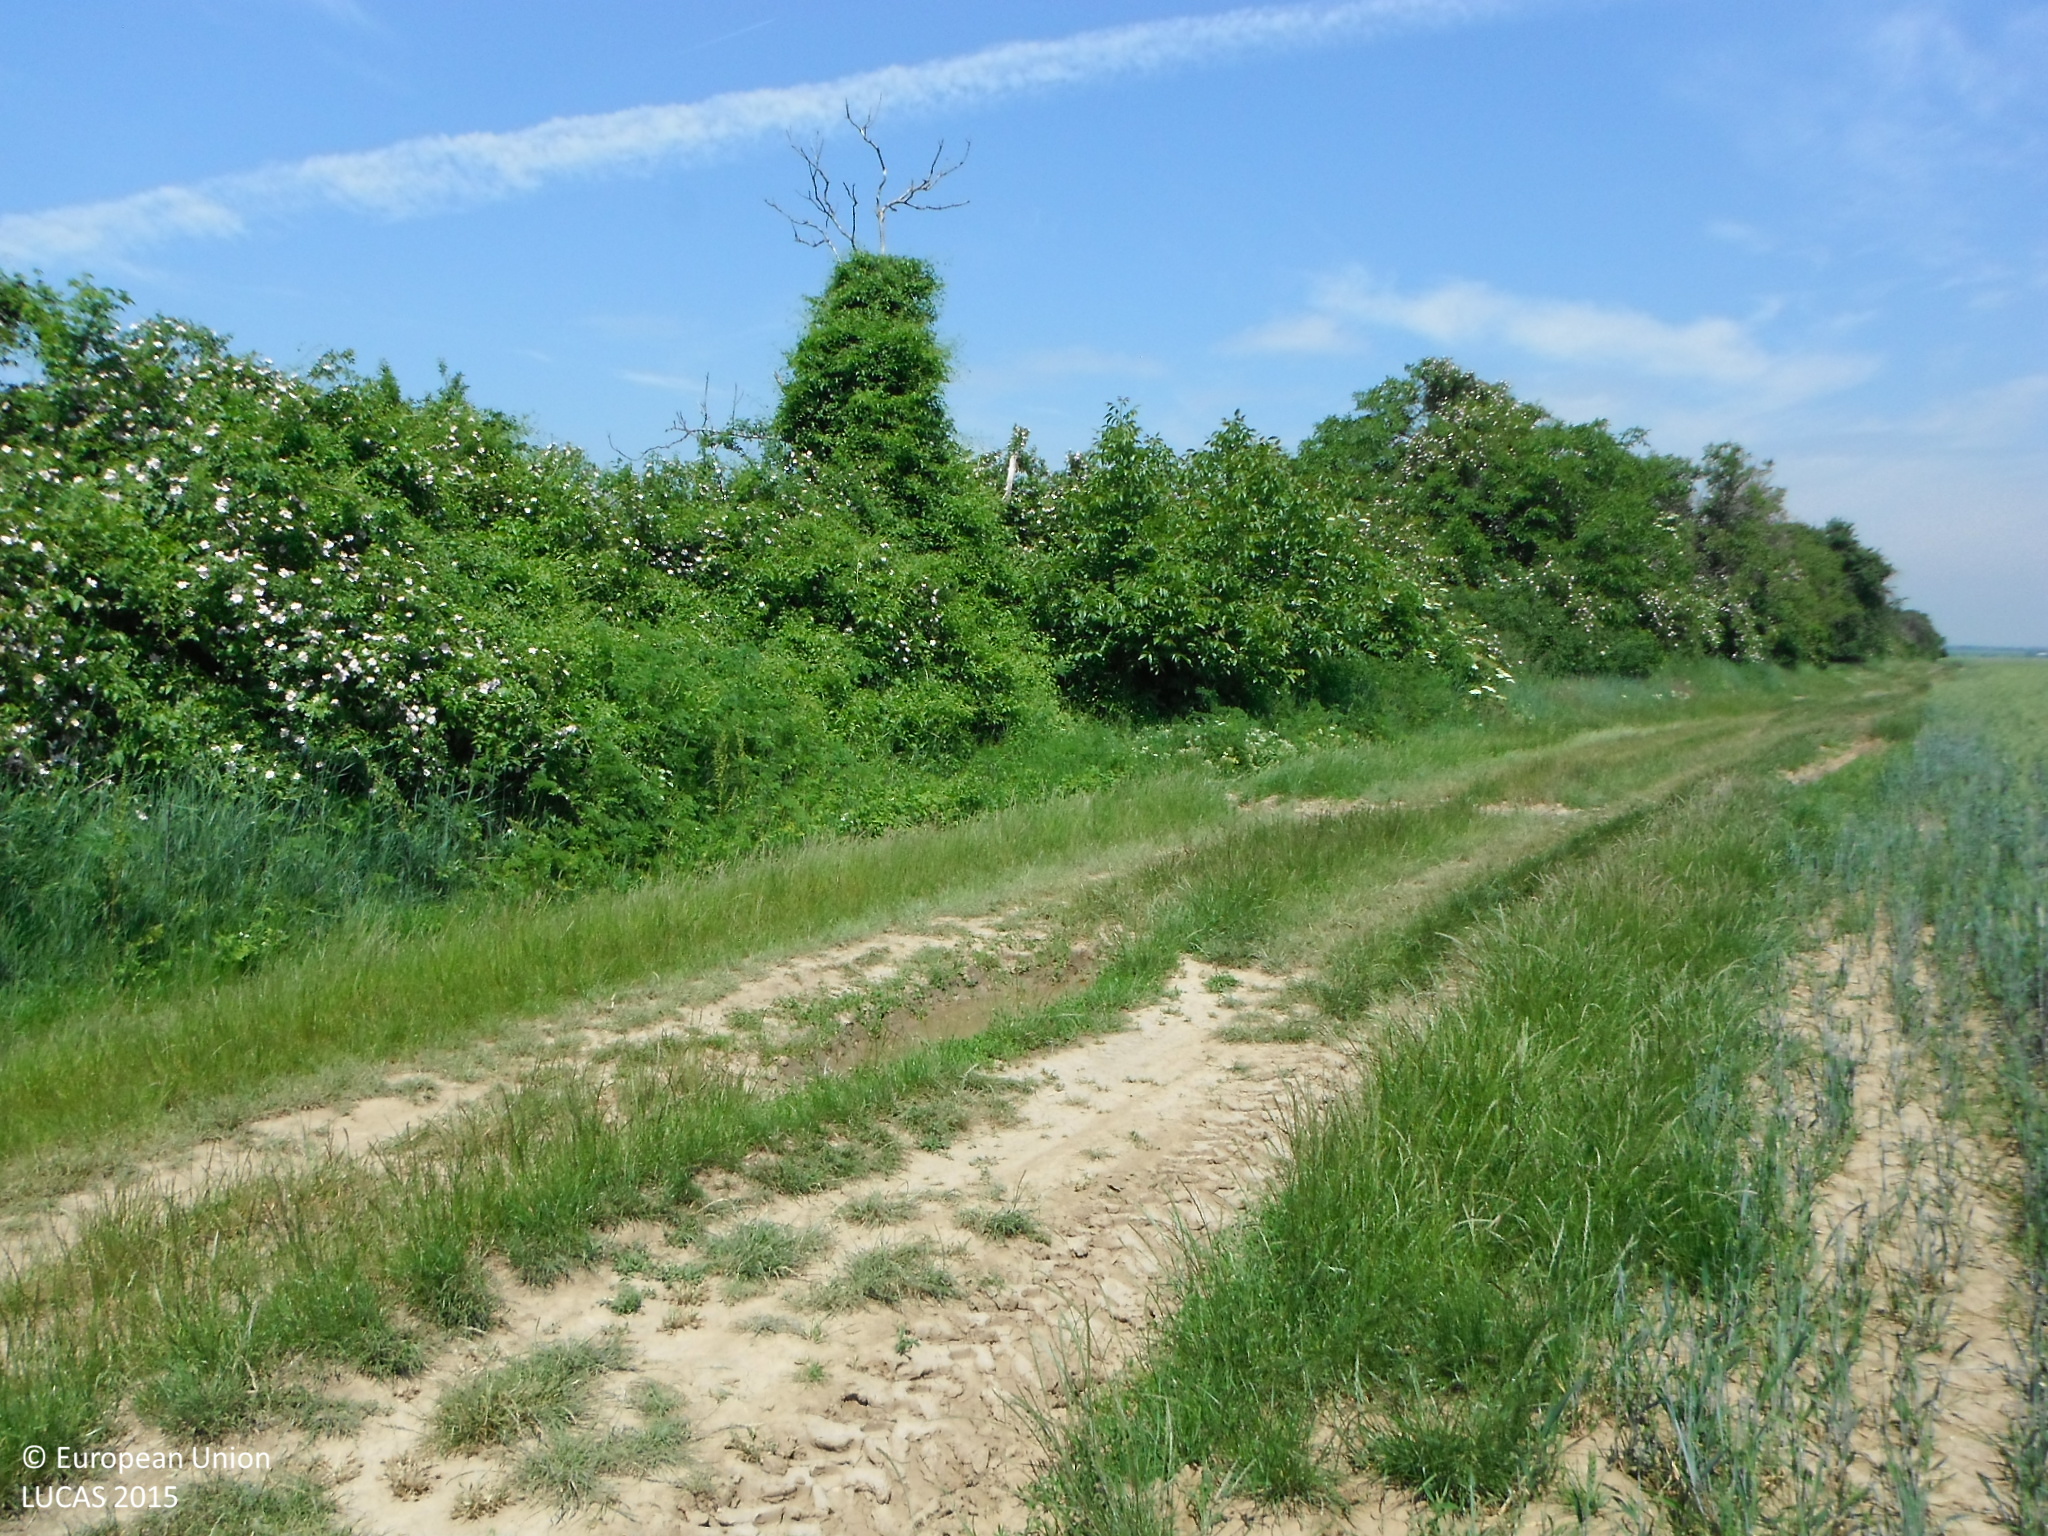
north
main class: Cropland
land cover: Common wheat
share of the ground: > 75 %
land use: Agriculture (excluding fallow land and kitchen gardens)
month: June
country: SK
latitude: 48.3171
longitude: 17.4132
